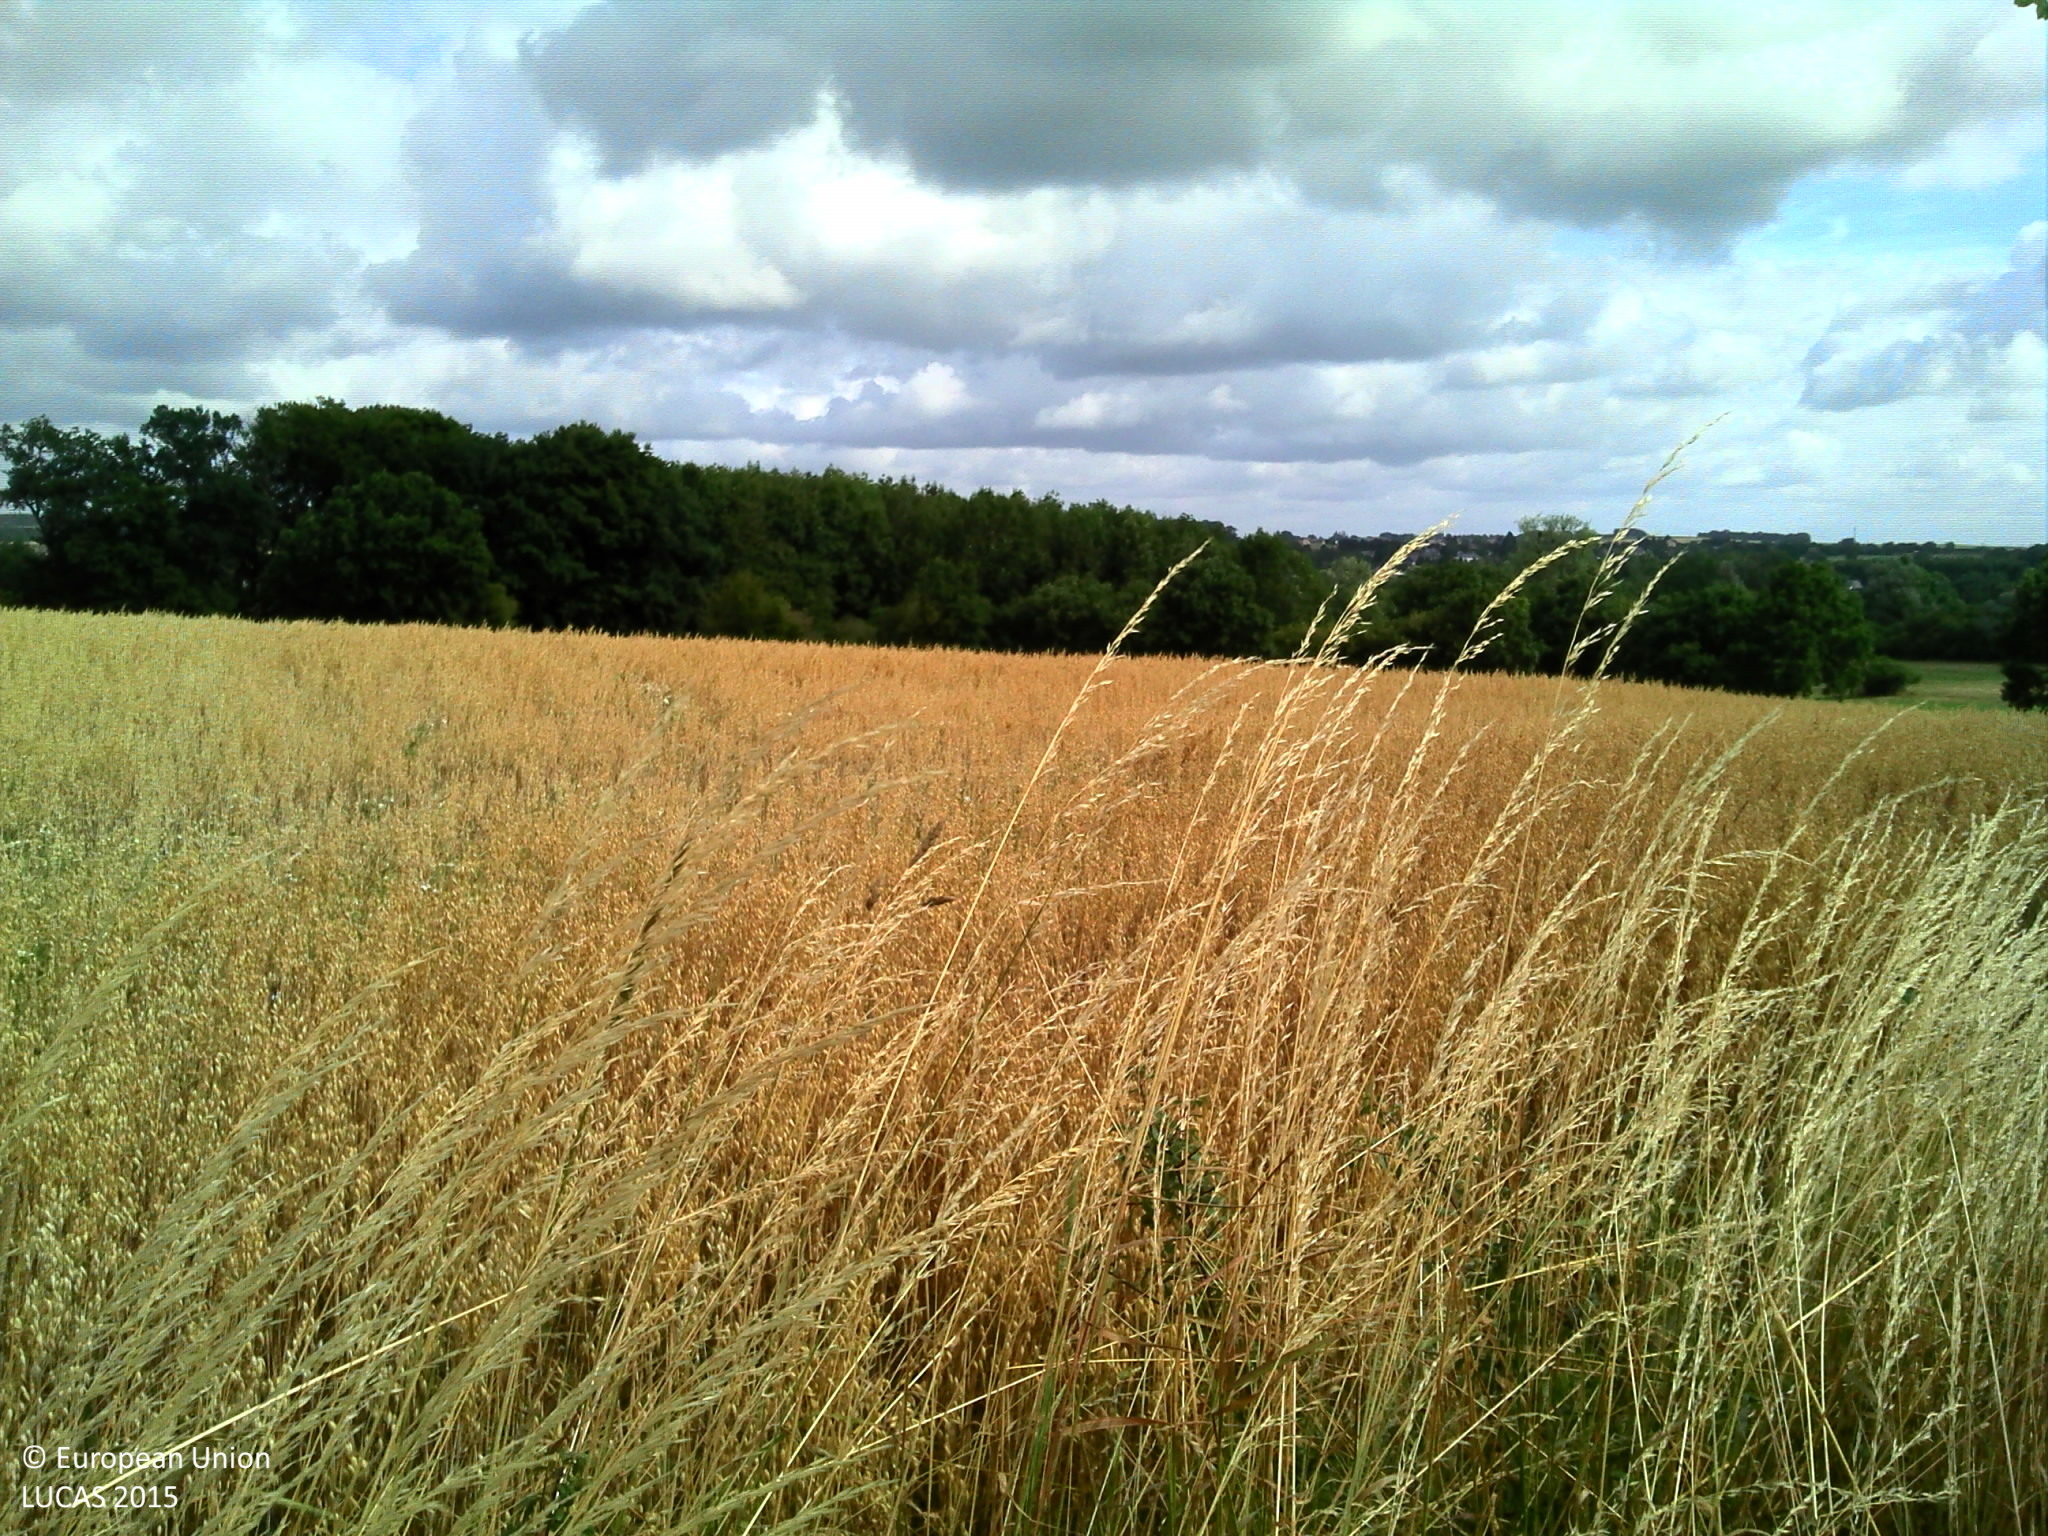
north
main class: Woodland
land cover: Broadleaved woodland
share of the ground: 50 - 75 %
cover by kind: broadleaved forest trees 50 %, shrubs 40 %, herbaceous plants 10 %
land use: Railway transport
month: July
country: BE
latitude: 49.6219
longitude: 5.8324
